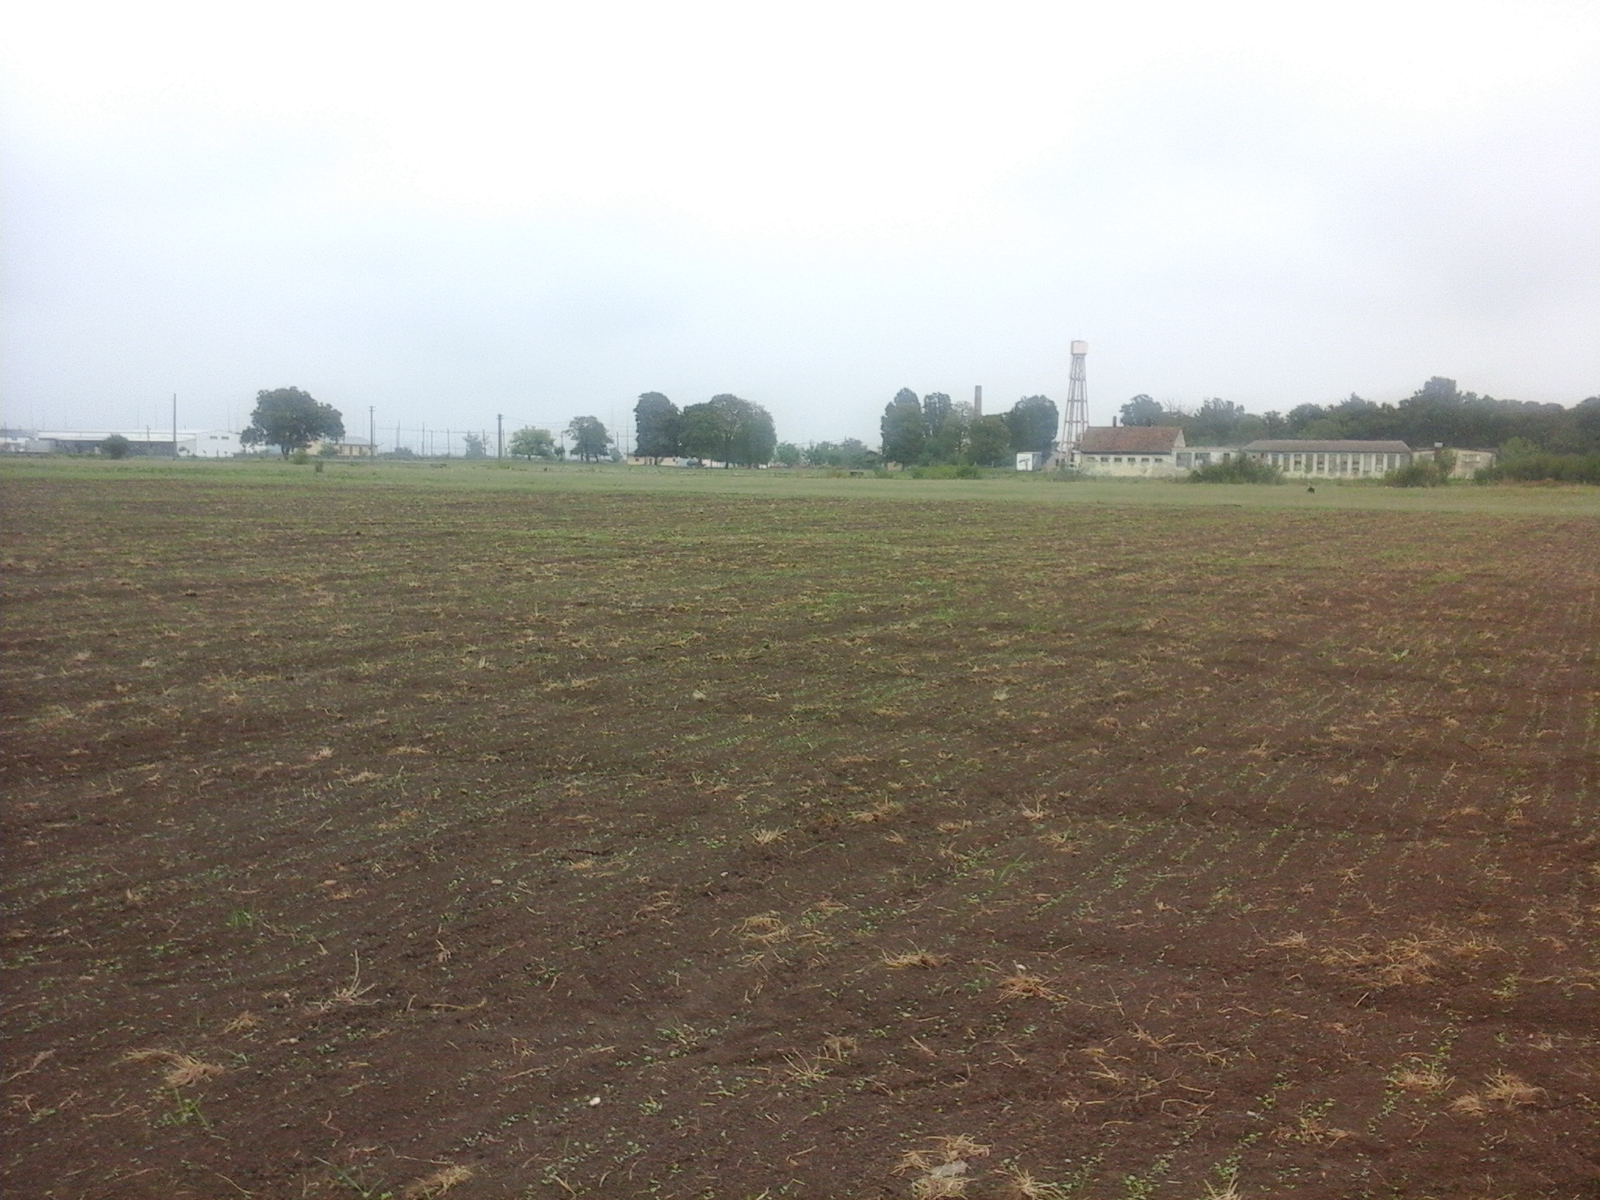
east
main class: Cropland
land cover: Dry pulses
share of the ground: < 10 %
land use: Agriculture (excluding fallow land and kitchen gardens)
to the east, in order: Dry pulses; Grassland without tree/shrub cover; Artificial constructions in urban areas; Grassland without tree/shrub cover; Artificial constructions in urban areas; Spontaneously vegetated surfaces; Artificial constructions in urban areas
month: September
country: RO
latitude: 47.0746
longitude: 21.8317
